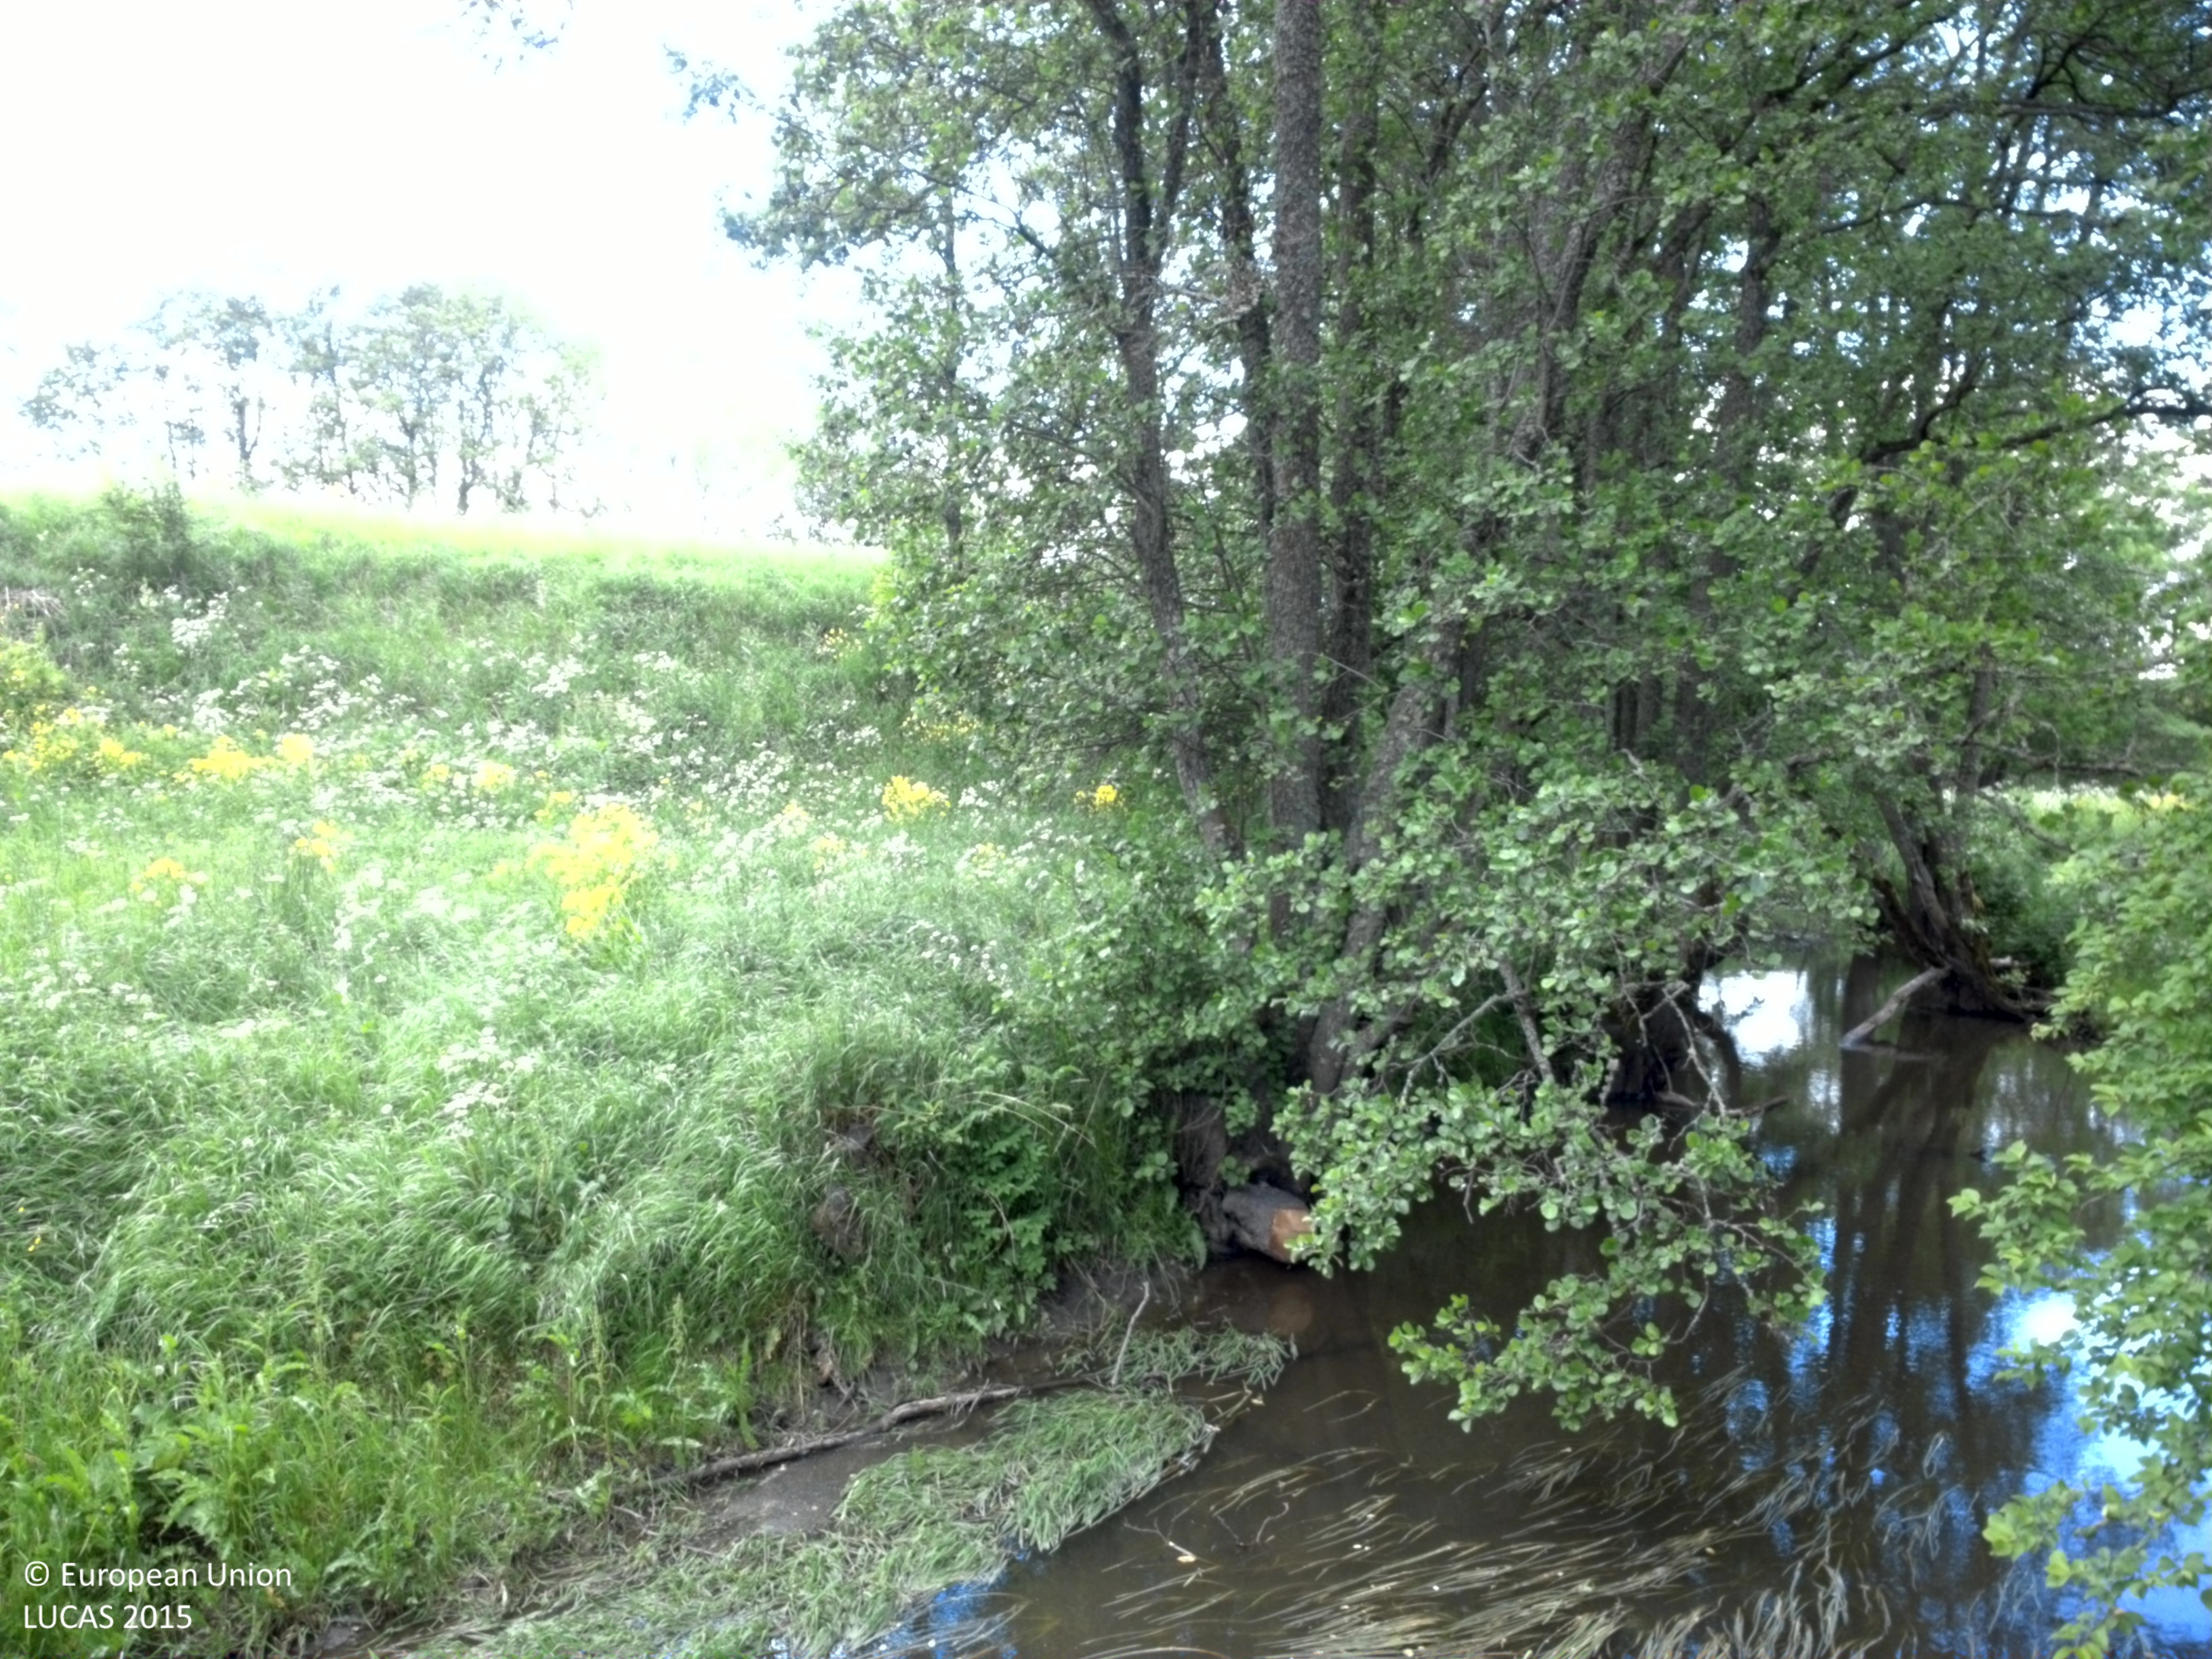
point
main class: Grassland
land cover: Grassland without tree/shrub cover
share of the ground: > 75 %
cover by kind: herbaceous plants 95 %, shrubs 5 %
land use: Agriculture (excluding fallow land and kitchen gardens)
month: June
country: SE
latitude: 59.9254
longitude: 17.5253
